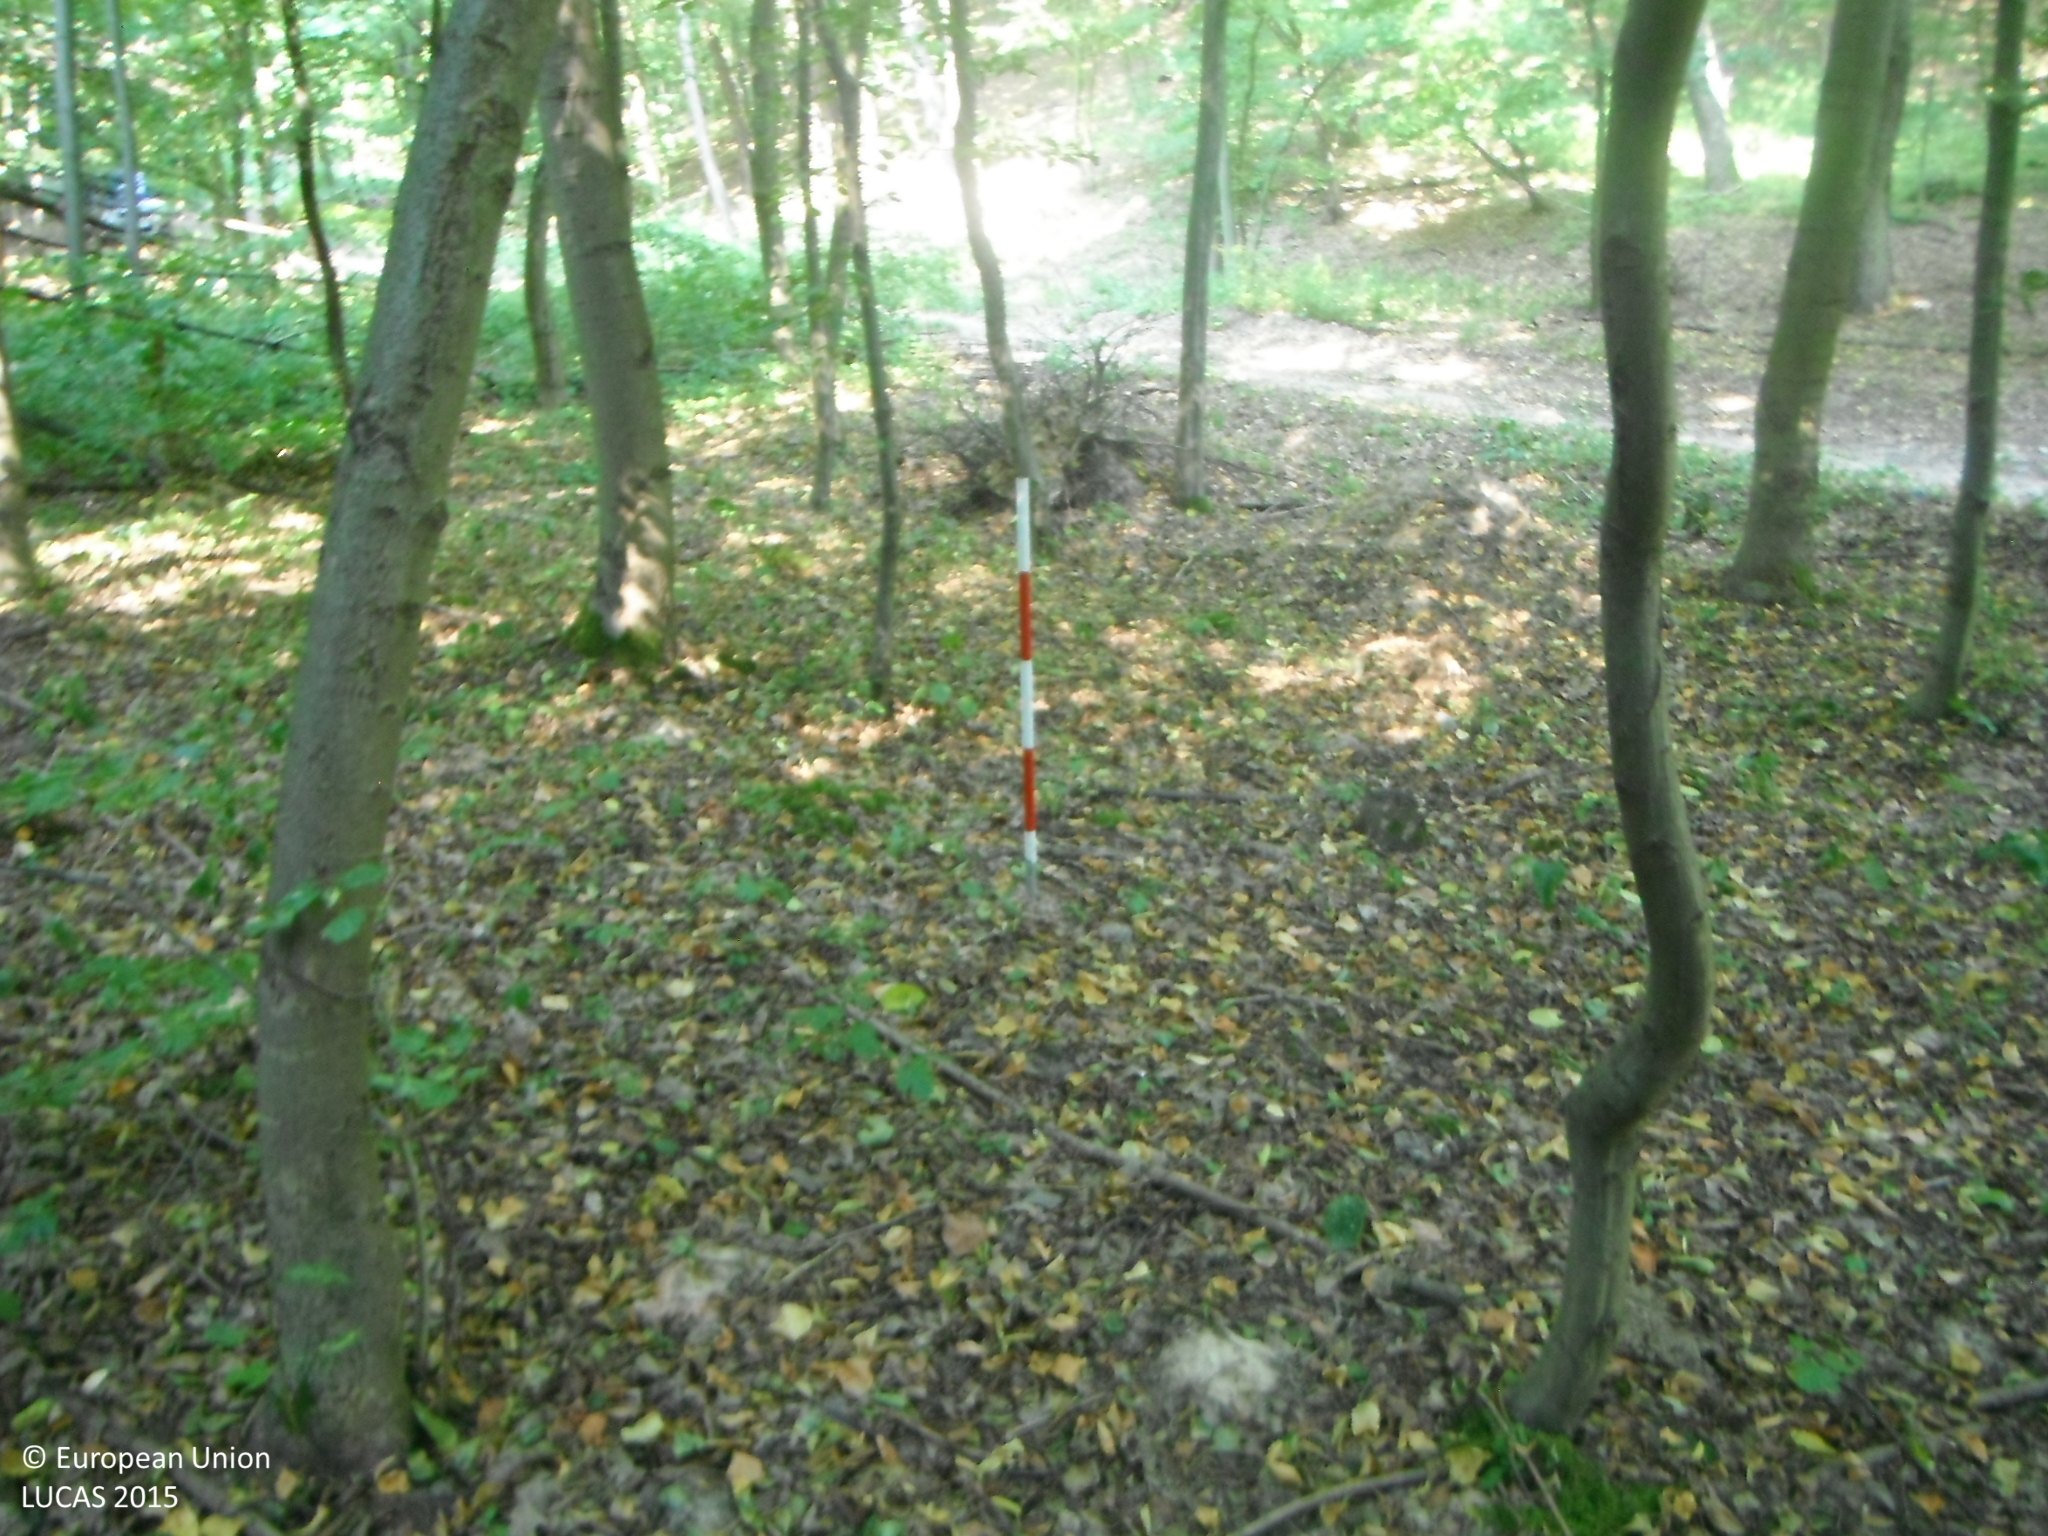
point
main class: Woodland
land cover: Broadleaved woodland
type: mesophytic deciduous forest
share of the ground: > 75 %
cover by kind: broadleaved forest trees 90 %, shrubs 5 %, unconsolidated bare surface 5 %
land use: Forestry
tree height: > 5 m
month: August
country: SK
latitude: 48.5934
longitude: 18.3546
